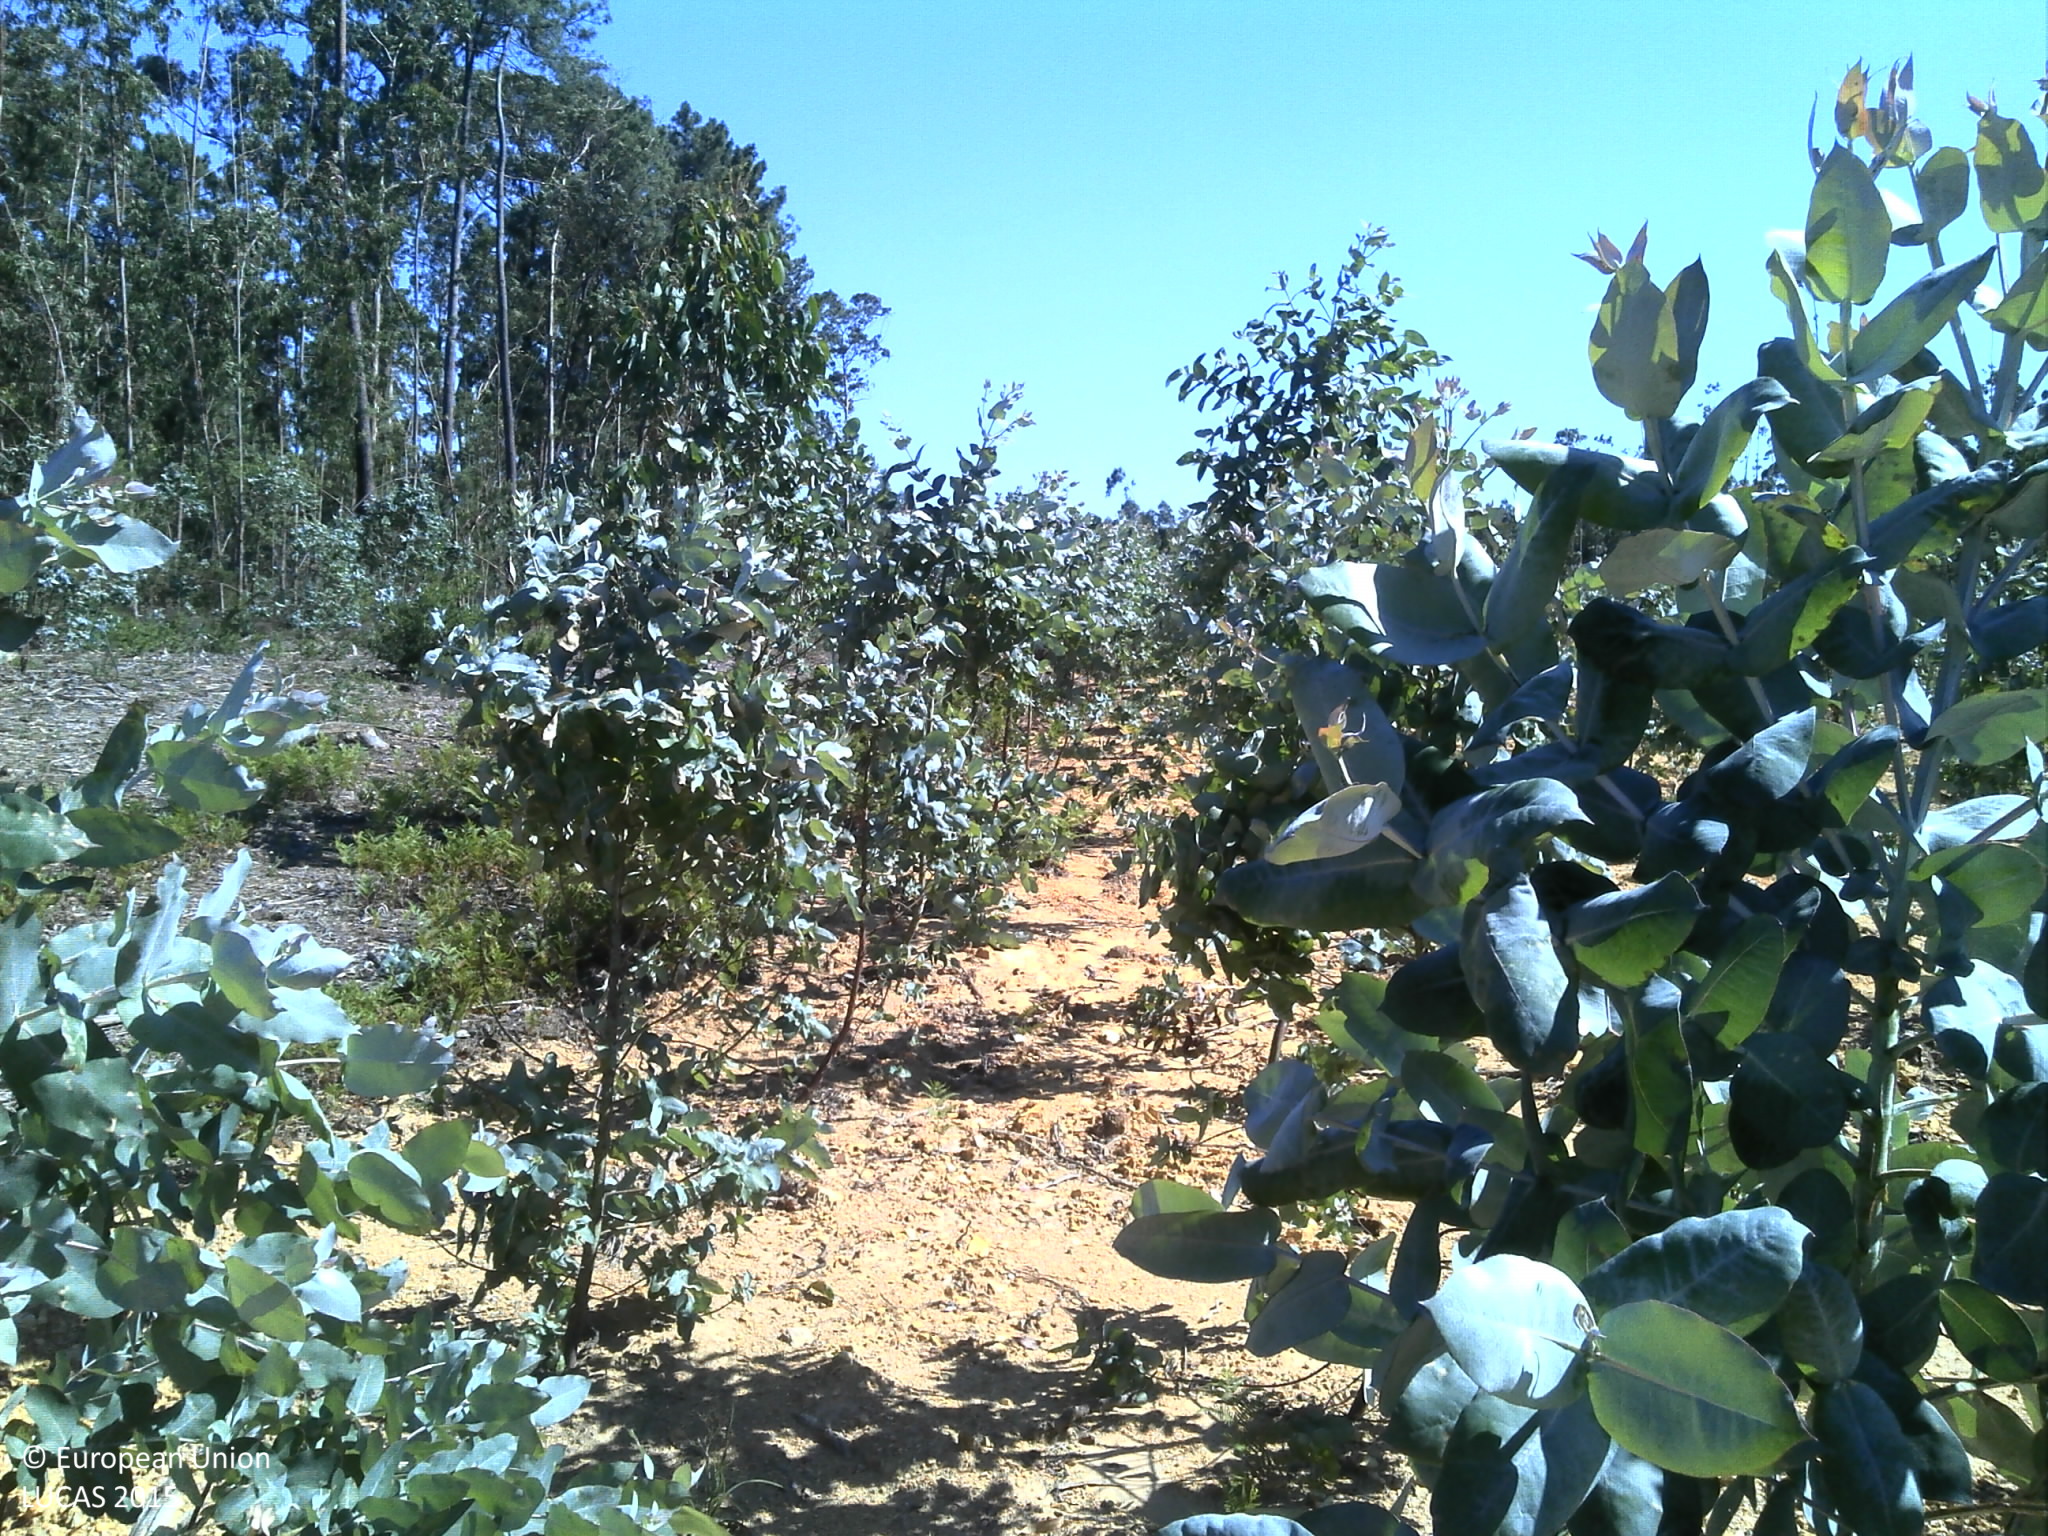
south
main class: Woodland
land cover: Broadleaved woodland
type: exotic forest
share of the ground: 25 - 50 %
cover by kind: unconsolidated bare surface 65 %, broadleaved forest trees 30 %, herbaceous plants 5 %
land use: Forestry
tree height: < 5 m
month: June
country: PT
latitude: 40.7320
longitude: -8.4827
